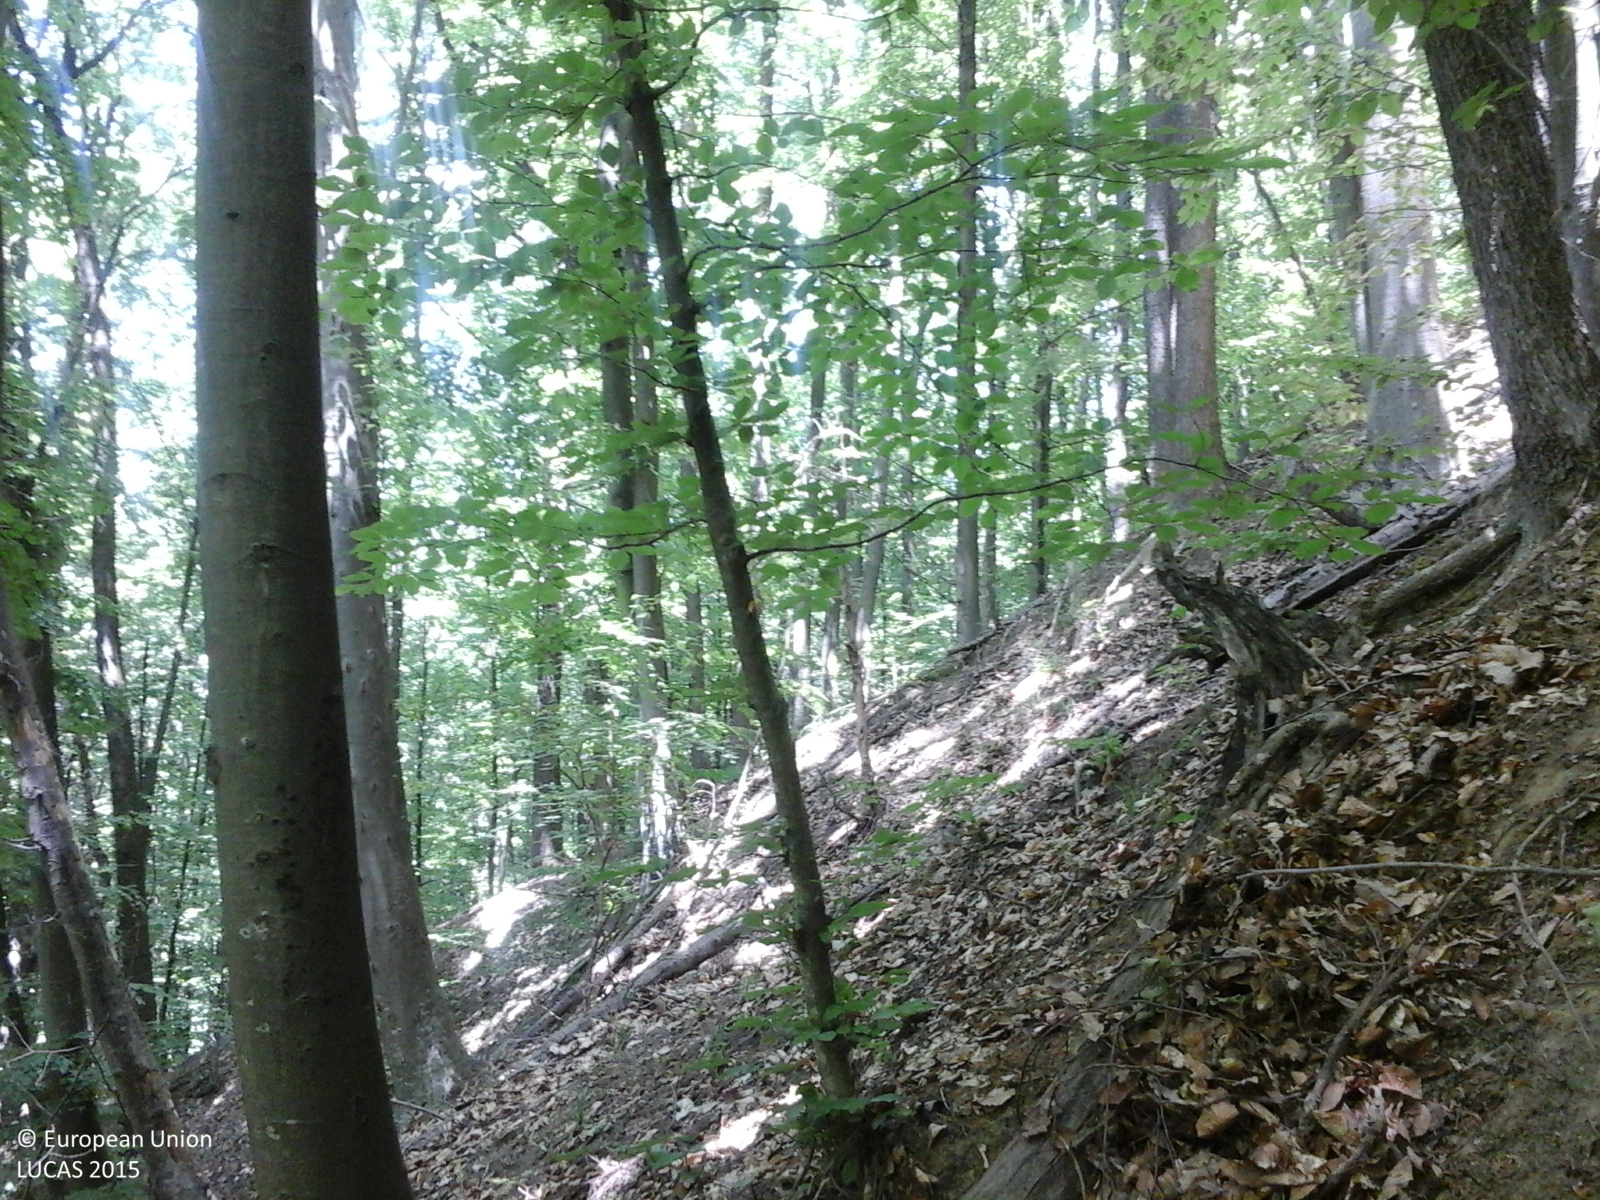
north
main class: Woodland
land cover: Broadleaved woodland
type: beech forest
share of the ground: > 75 %
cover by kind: broadleaved forest trees 100 %
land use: Forestry
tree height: > 5 m
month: June
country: RO
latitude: 46.6015
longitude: 26.7337
